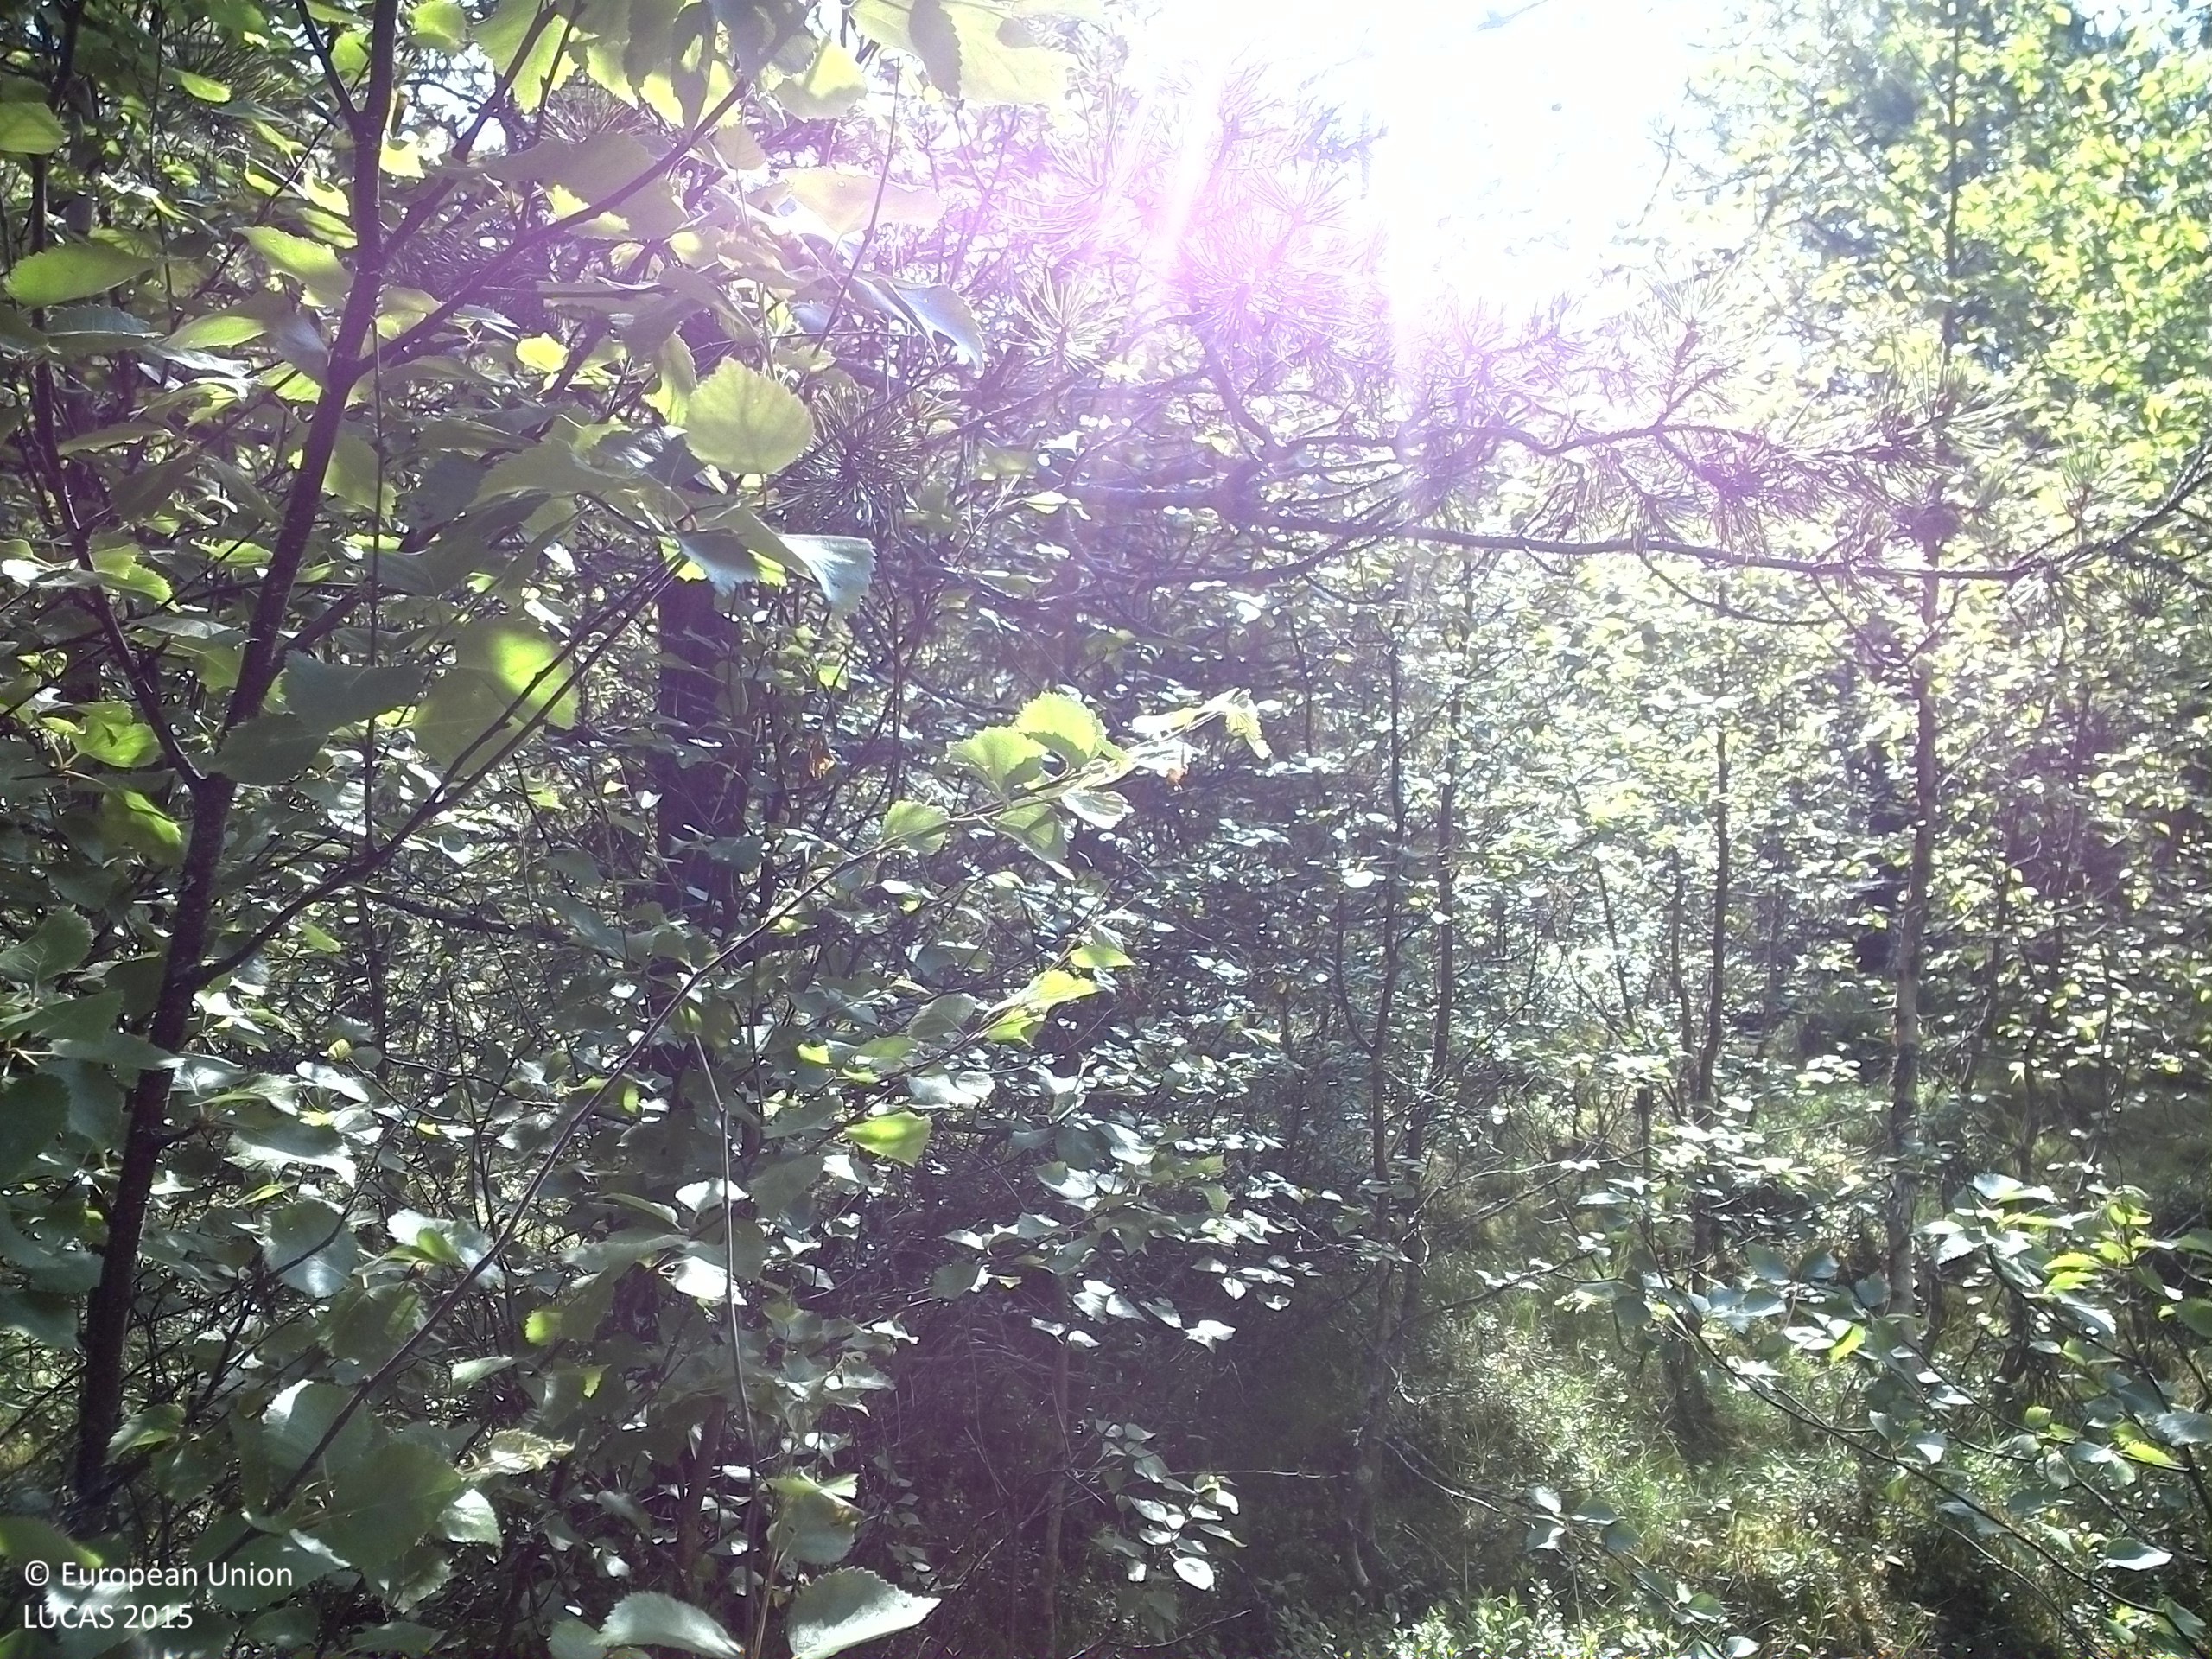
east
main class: Woodland
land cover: Pine dominated mixed woodland
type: exotic forest
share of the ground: 50 - 75 %
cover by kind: coniferous forest trees 50 %, broadleaved forest trees 20 %, shrubs 15 %, herbaceous plants 10 %, lichens and mosses 5 %
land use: Forestry
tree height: > 5 m
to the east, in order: Pine dominated mixed woodland; Spruce dominated coniferous woodland; Ditches and canals; Spruce dominated mixed woodland; Pine dominated coniferous woodland; Tracks; Pine dominated coniferous woodland
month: July
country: SE
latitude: 63.5542
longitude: 17.4000
